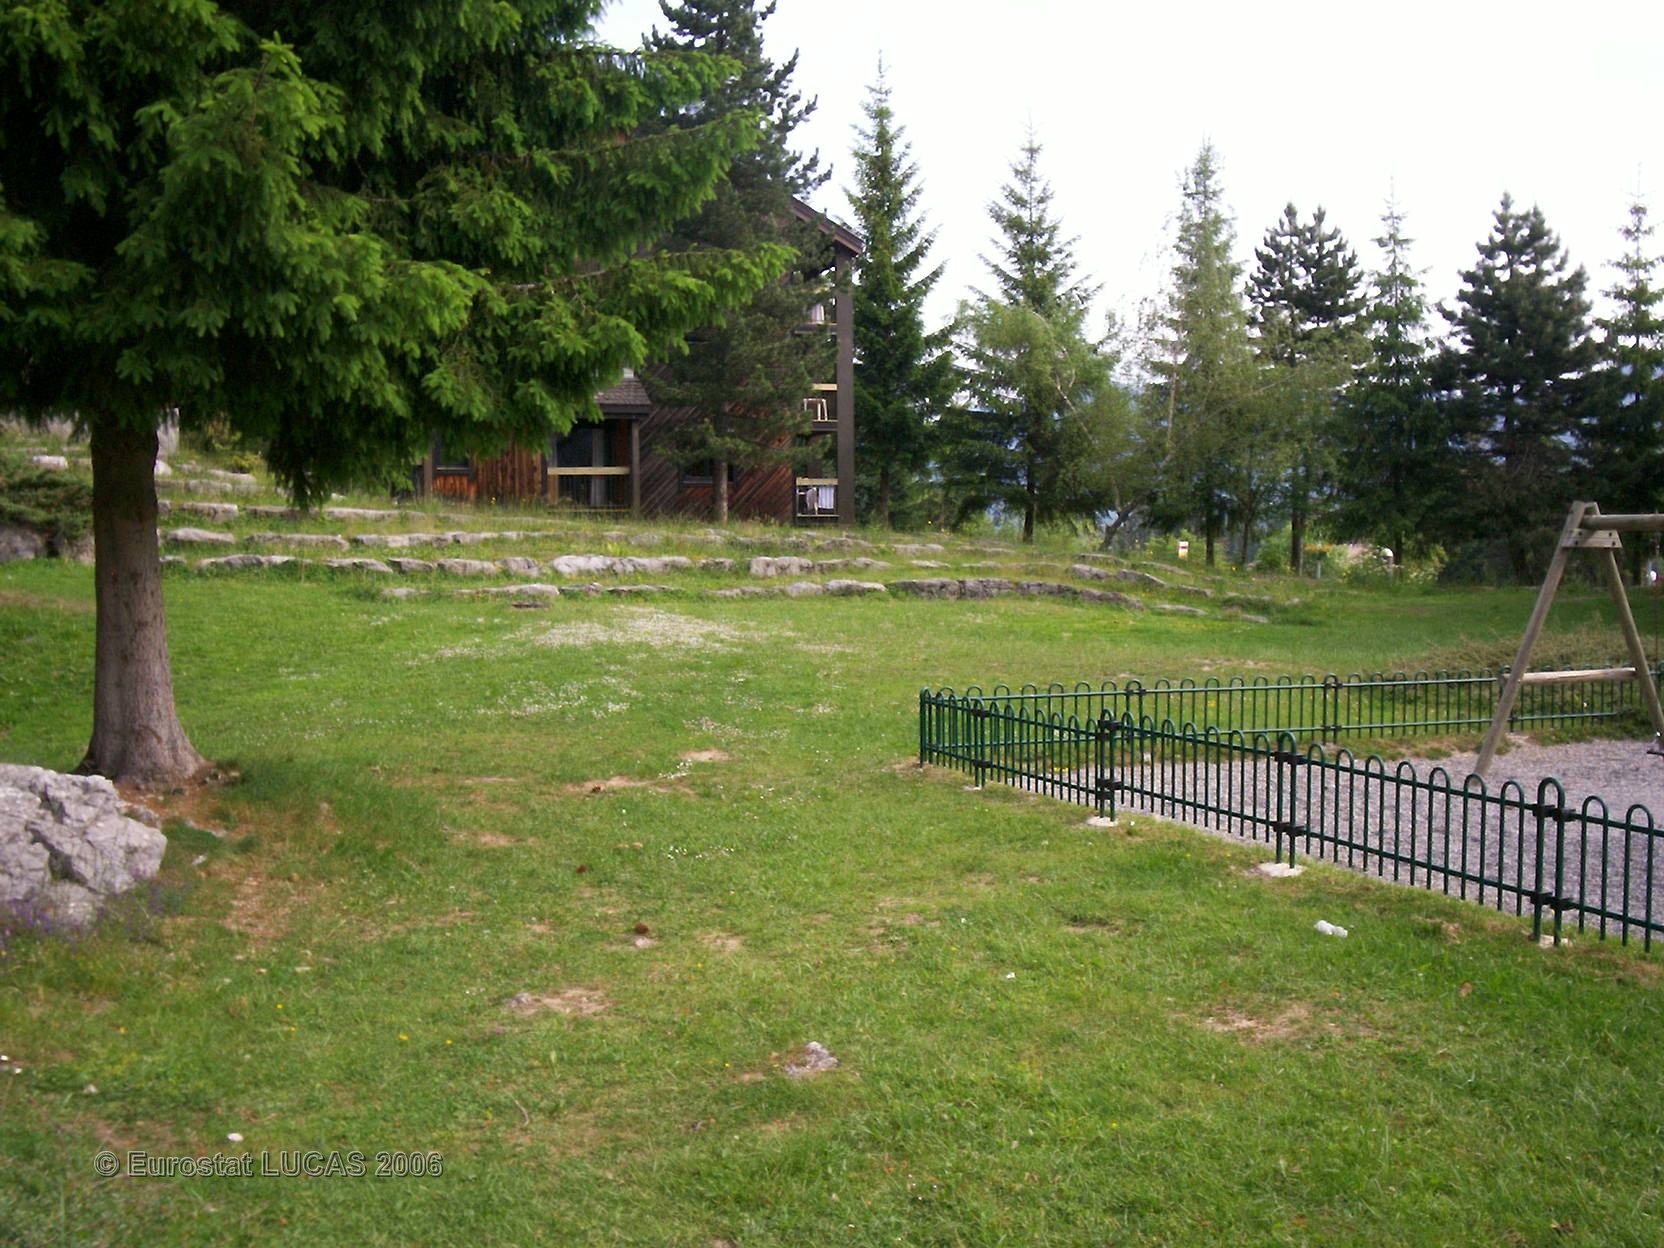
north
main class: Grassland
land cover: Grassland with sparse tree/shrub cover
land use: Residential
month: June
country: FR
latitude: 46.0278
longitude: 6.6319
